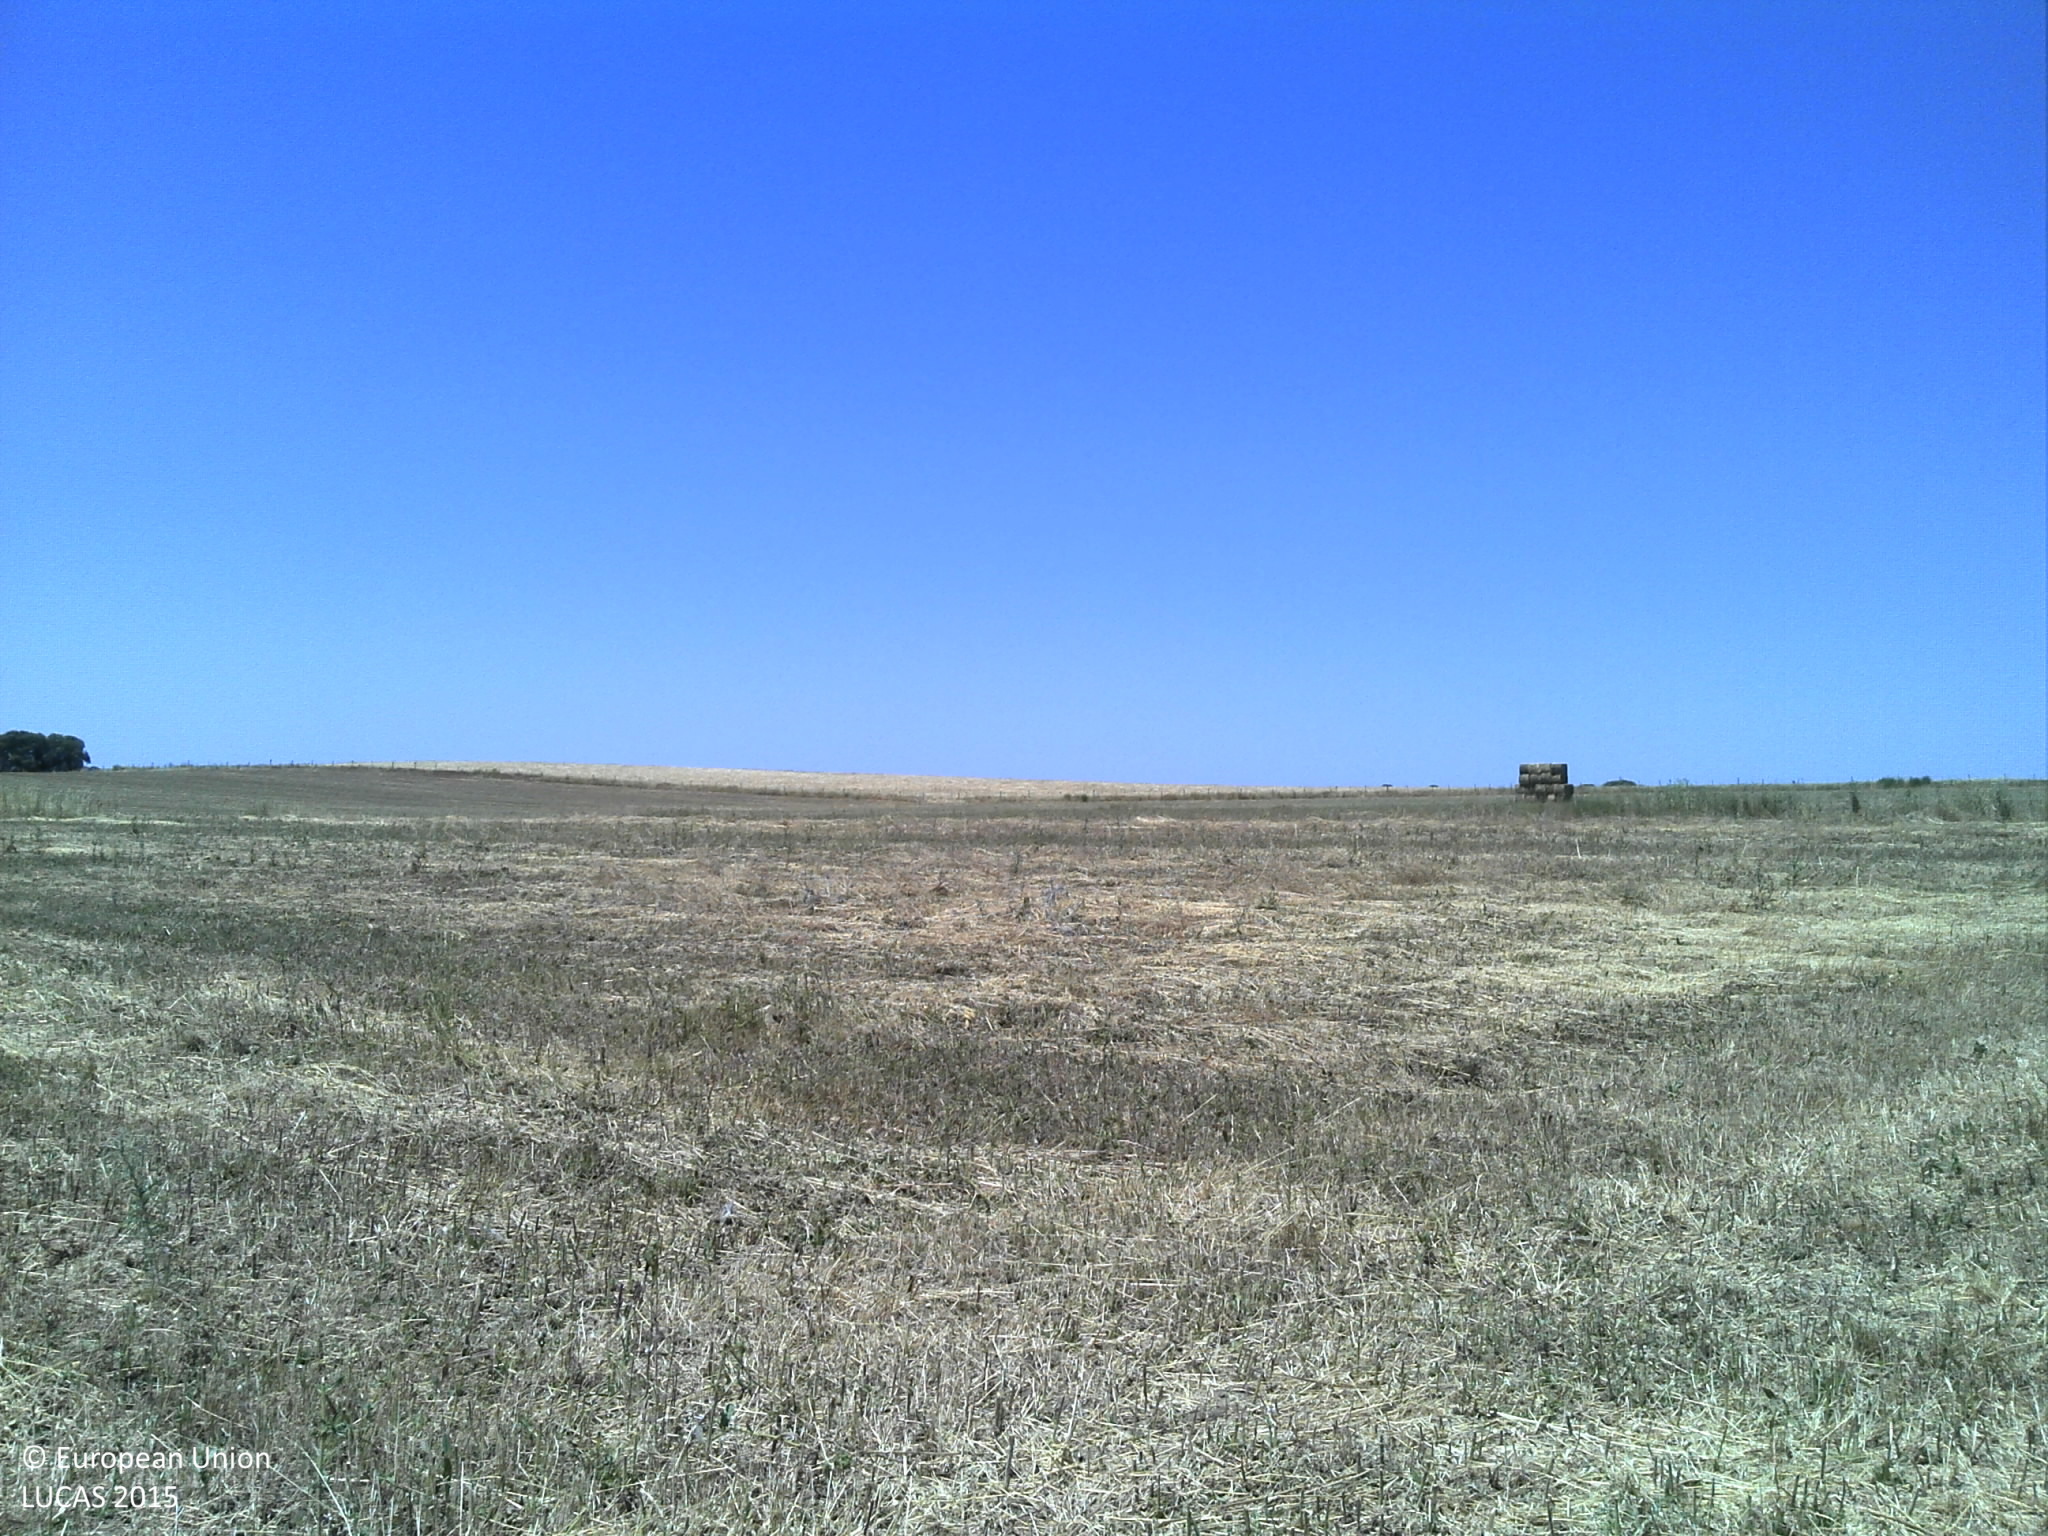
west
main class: Cropland
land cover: Oats
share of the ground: 10 - 25 %
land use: Agriculture (excluding fallow land and kitchen gardens)
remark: Harvested field
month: May
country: PT
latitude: 38.9943
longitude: -7.6012
